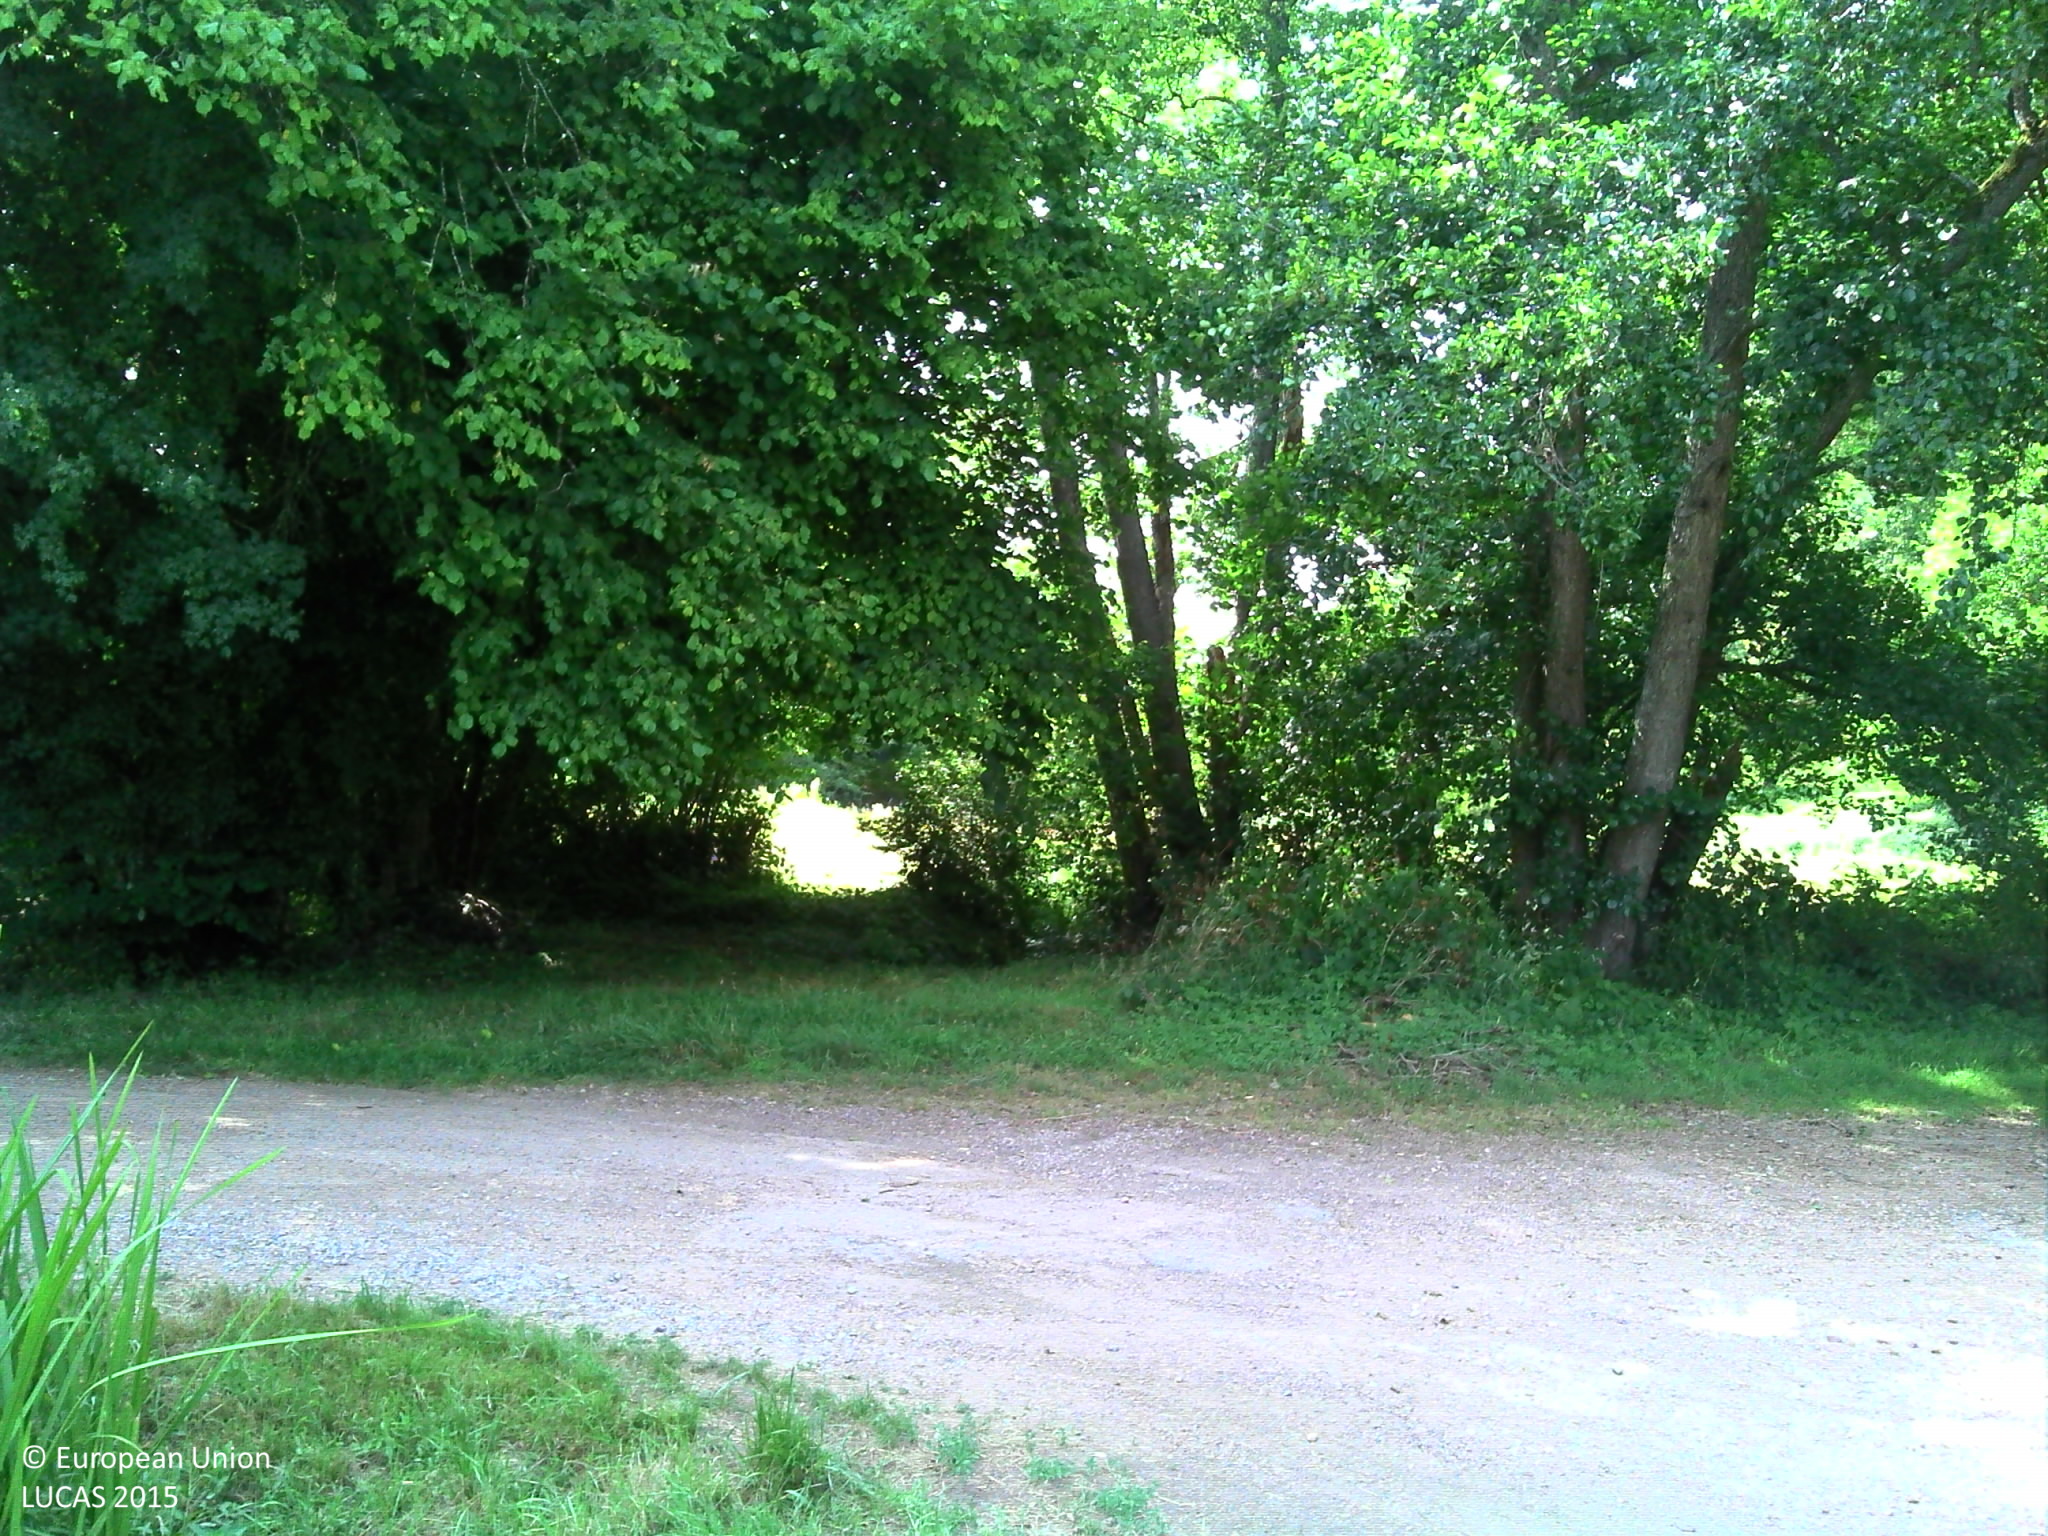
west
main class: Grassland
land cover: Grassland without tree/shrub cover
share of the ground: > 75 %
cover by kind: herbaceous plants 100 %
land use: Agriculture (excluding fallow land and kitchen gardens)
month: July
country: FR
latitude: 47.0407
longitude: 3.5354
